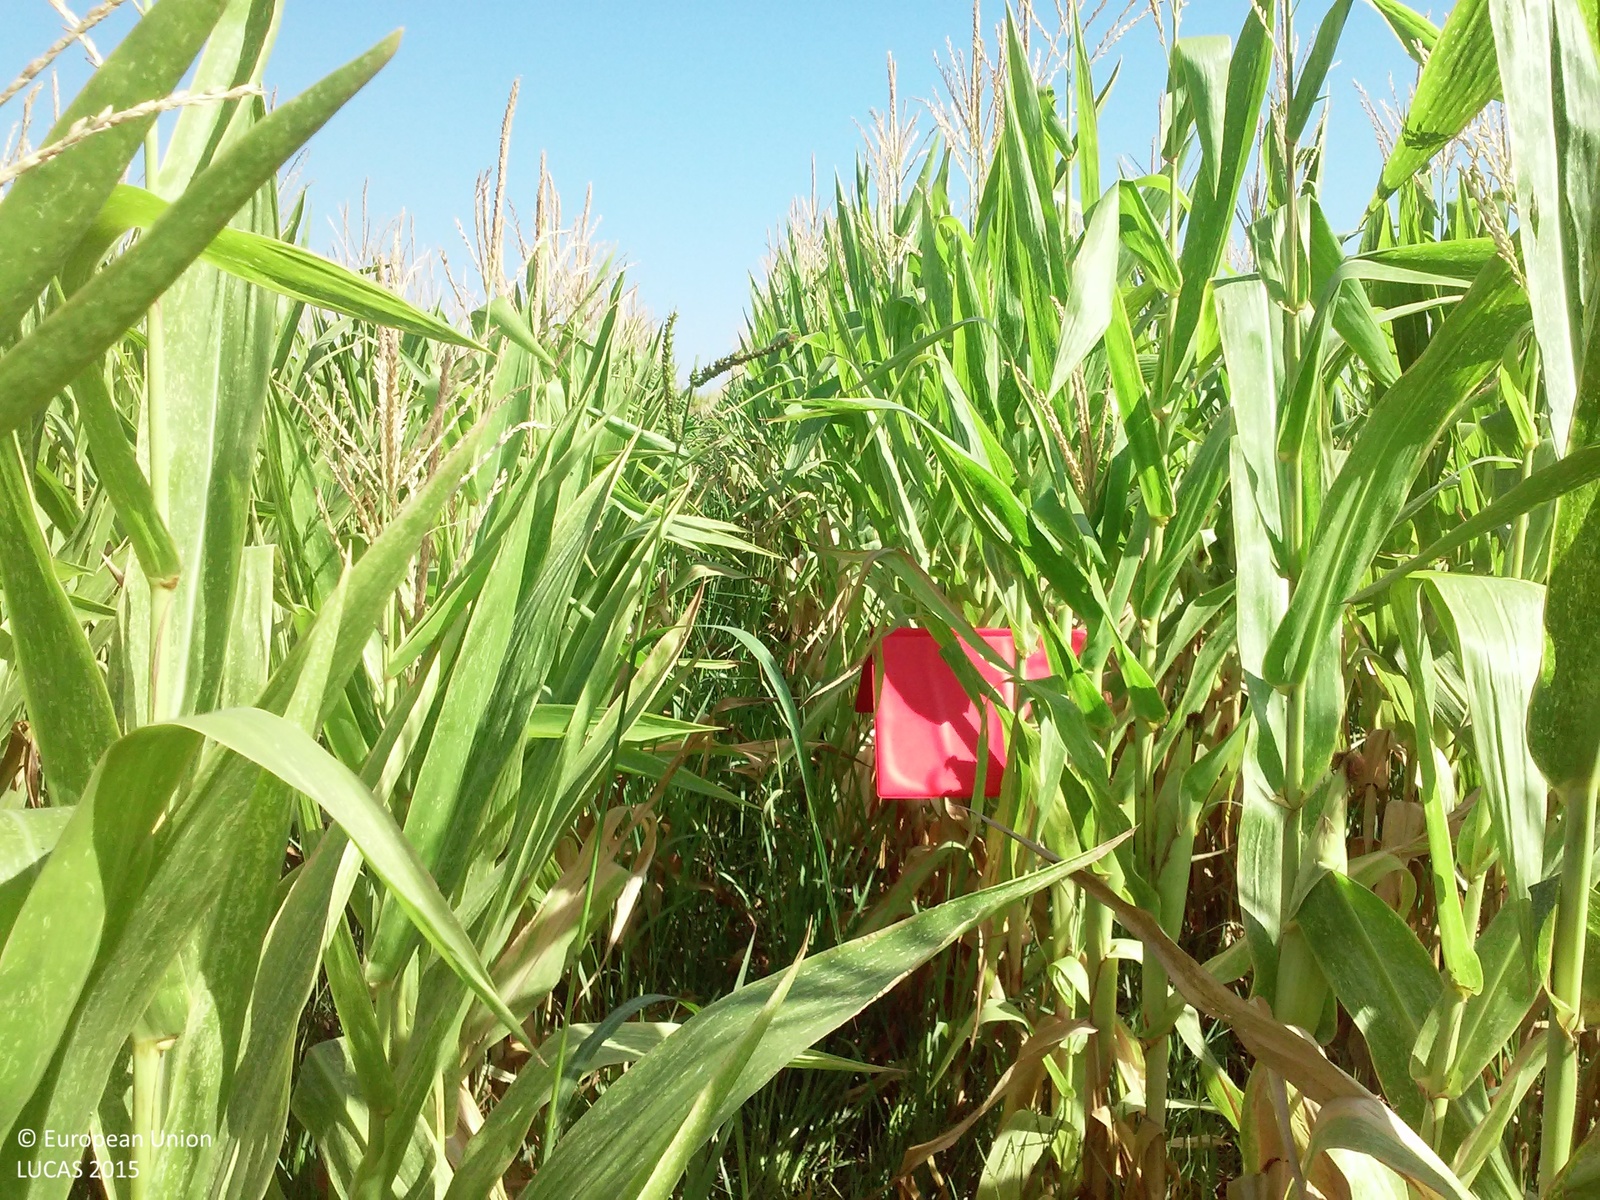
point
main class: Cropland
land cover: Maize
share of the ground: > 75 %
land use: Agriculture (excluding fallow land and kitchen gardens)
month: July
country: ES
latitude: 41.6960
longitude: 0.6751
